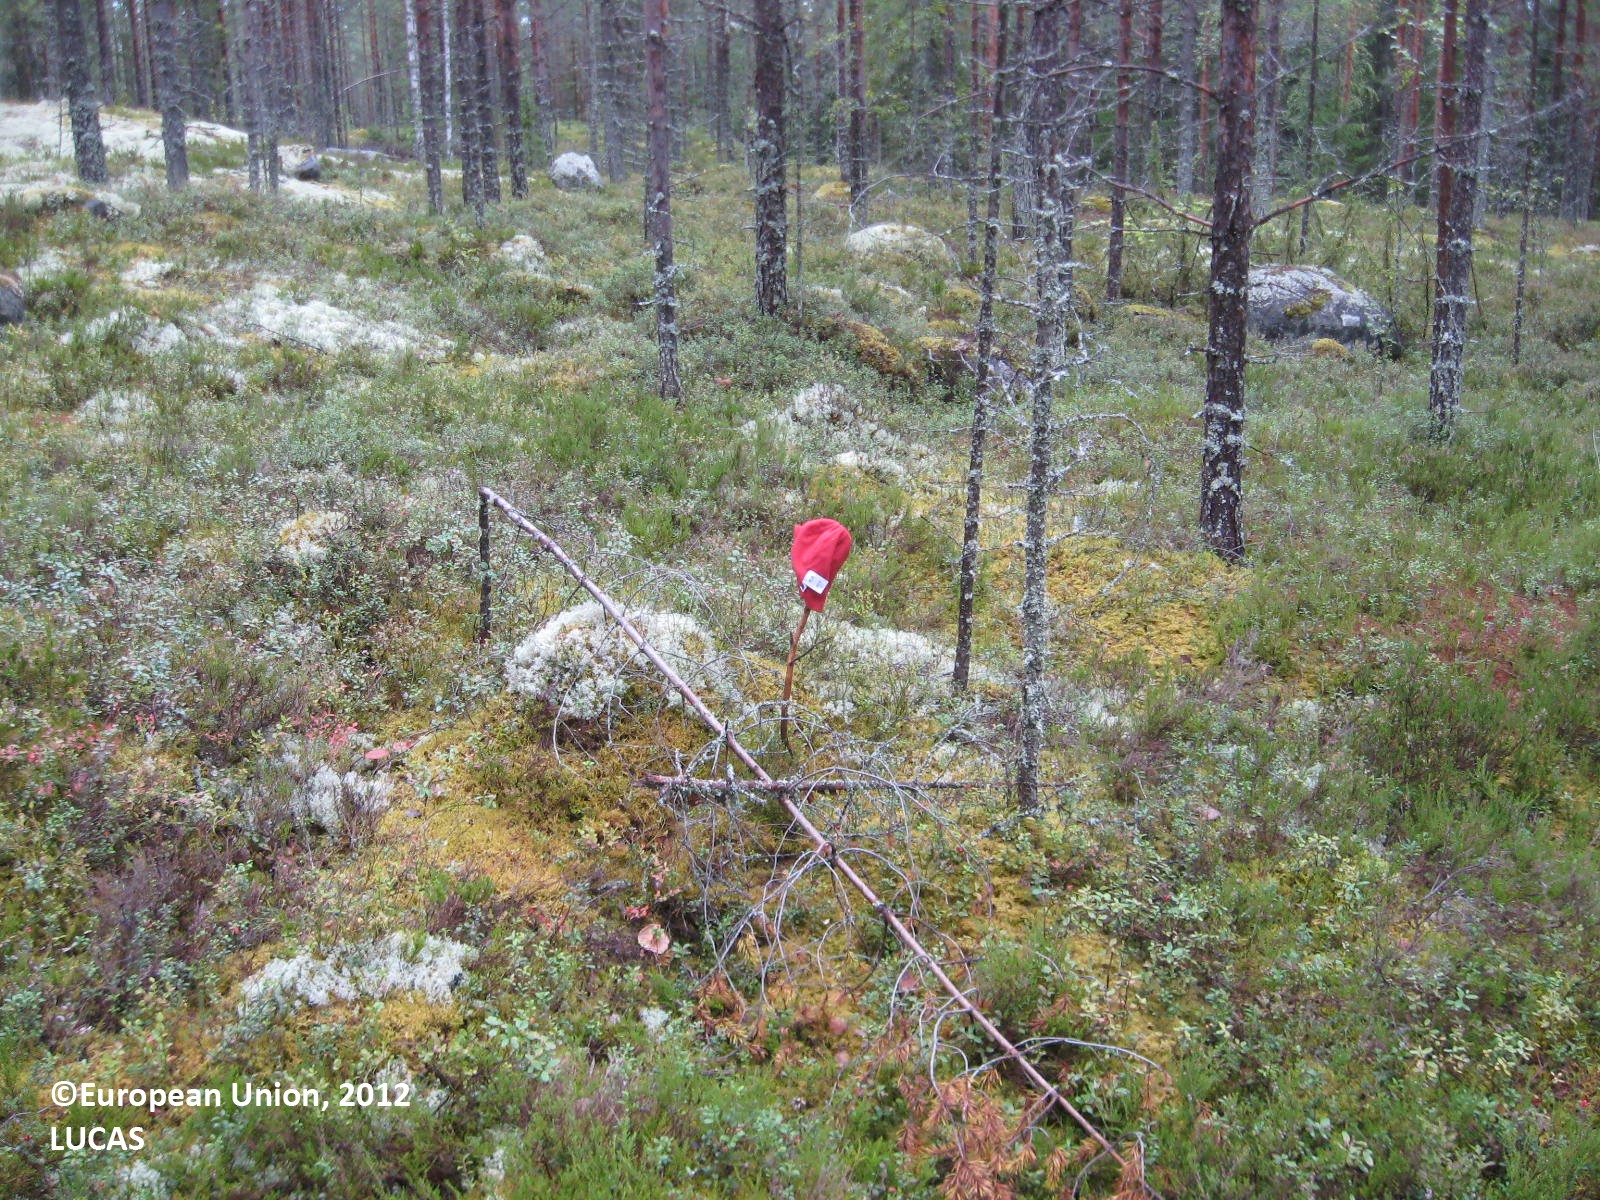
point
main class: Woodland
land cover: Pine dominated coniferous woodland
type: boreal forest
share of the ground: > 75 %
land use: Forestry
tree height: > 5 m
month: August
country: FI
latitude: 63.4859
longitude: 29.3559
